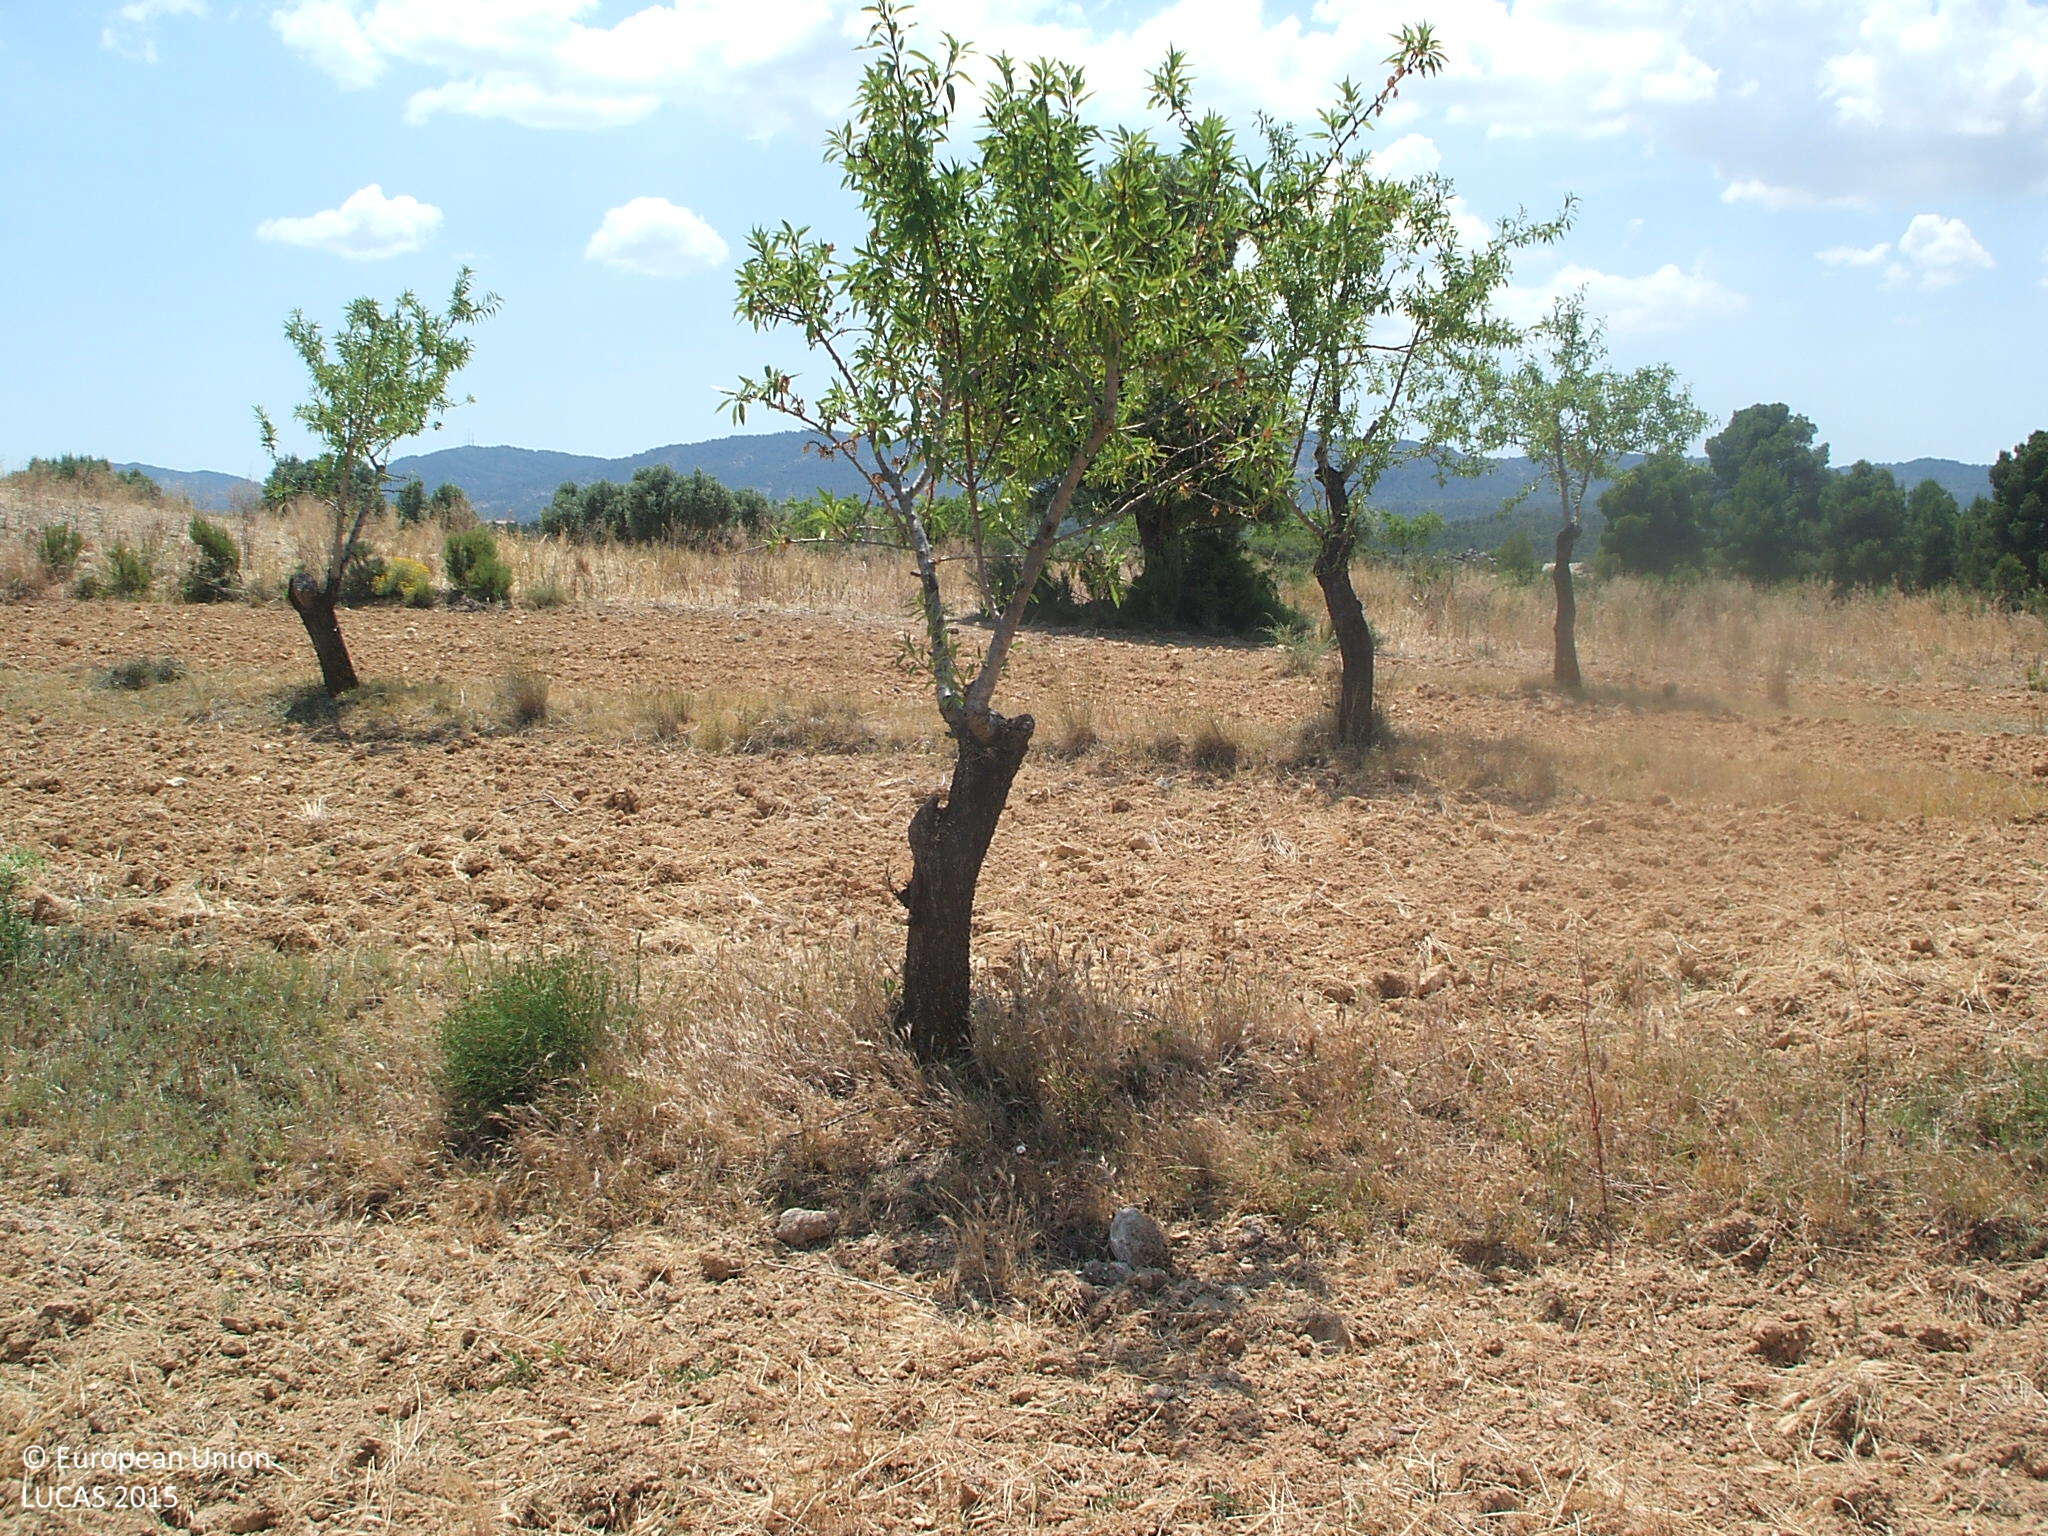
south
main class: Cropland
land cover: Nuts trees
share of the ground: 10 - 25 %
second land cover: Other bare soil
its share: > 75 %
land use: Agriculture (excluding fallow land and kitchen gardens)
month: June
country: ES
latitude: 40.9271
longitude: -0.1162
